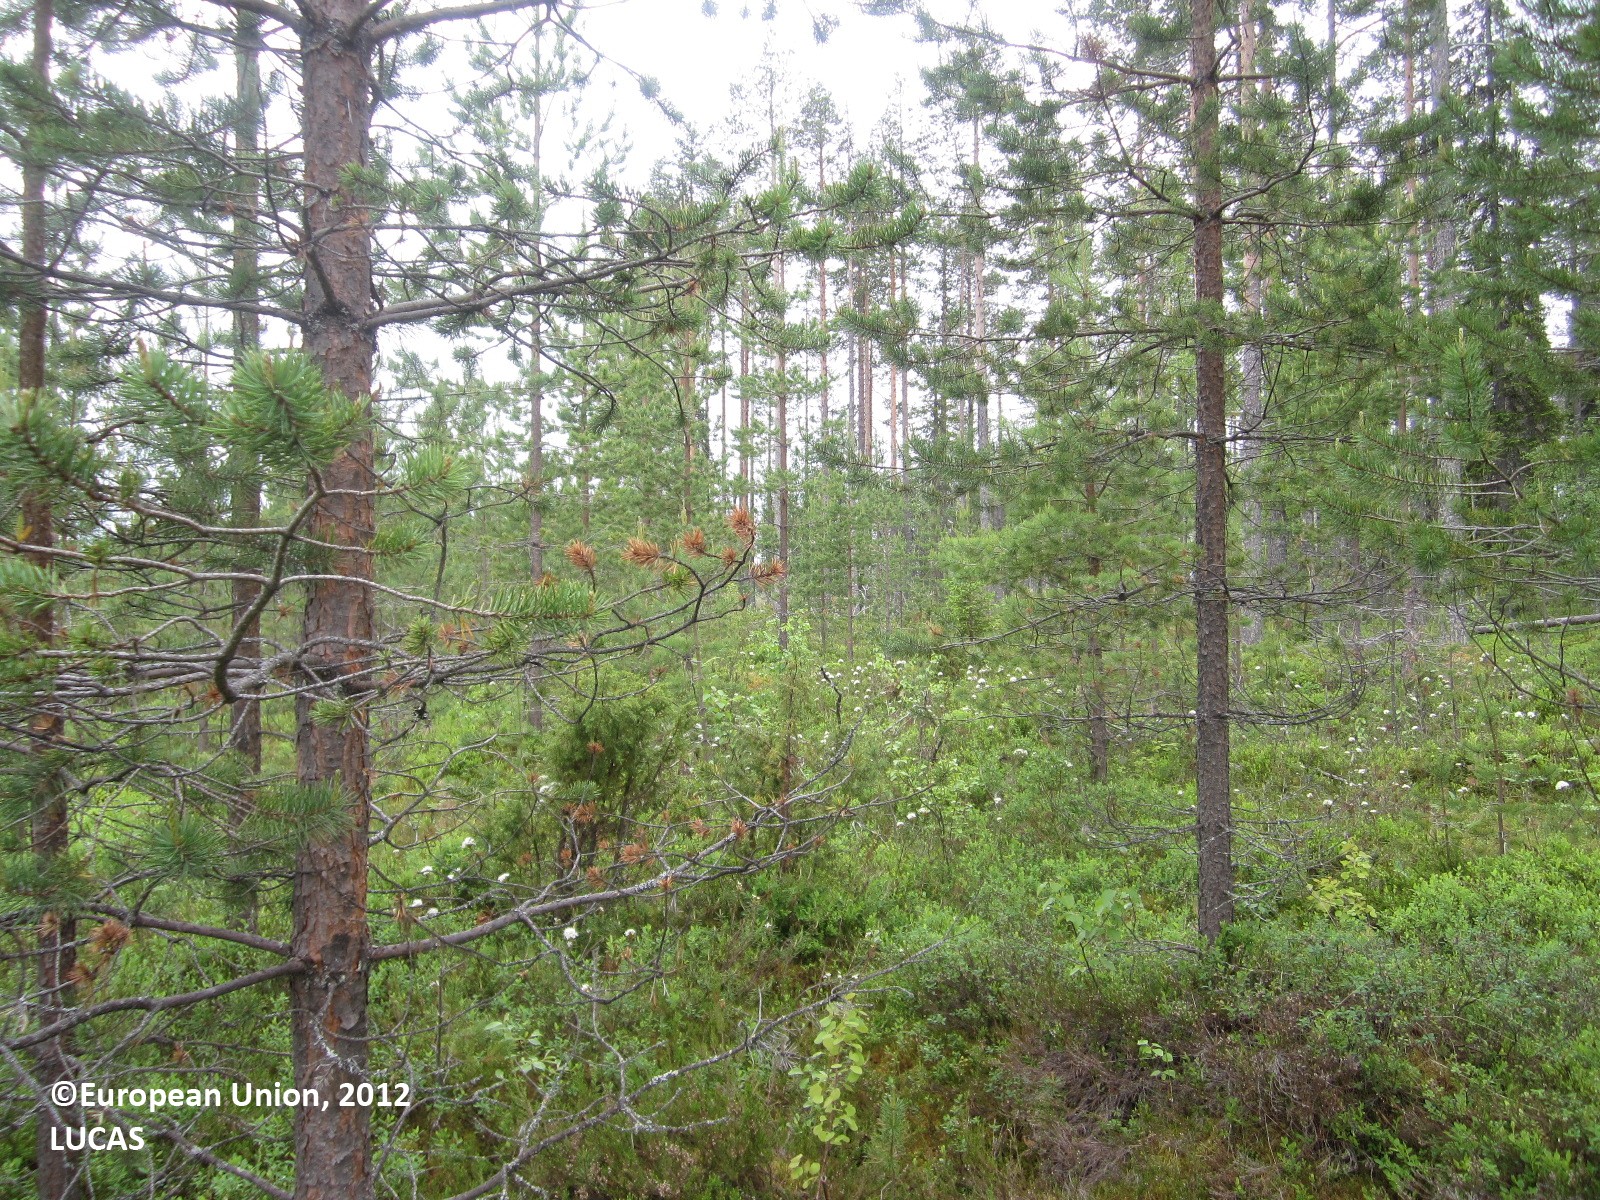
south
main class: Woodland
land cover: Pine dominated coniferous woodland
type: boreal forest
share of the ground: 25 - 50 %
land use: Forestry
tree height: > 5 m
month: June
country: FI
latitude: 64.7253
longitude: 29.9389
